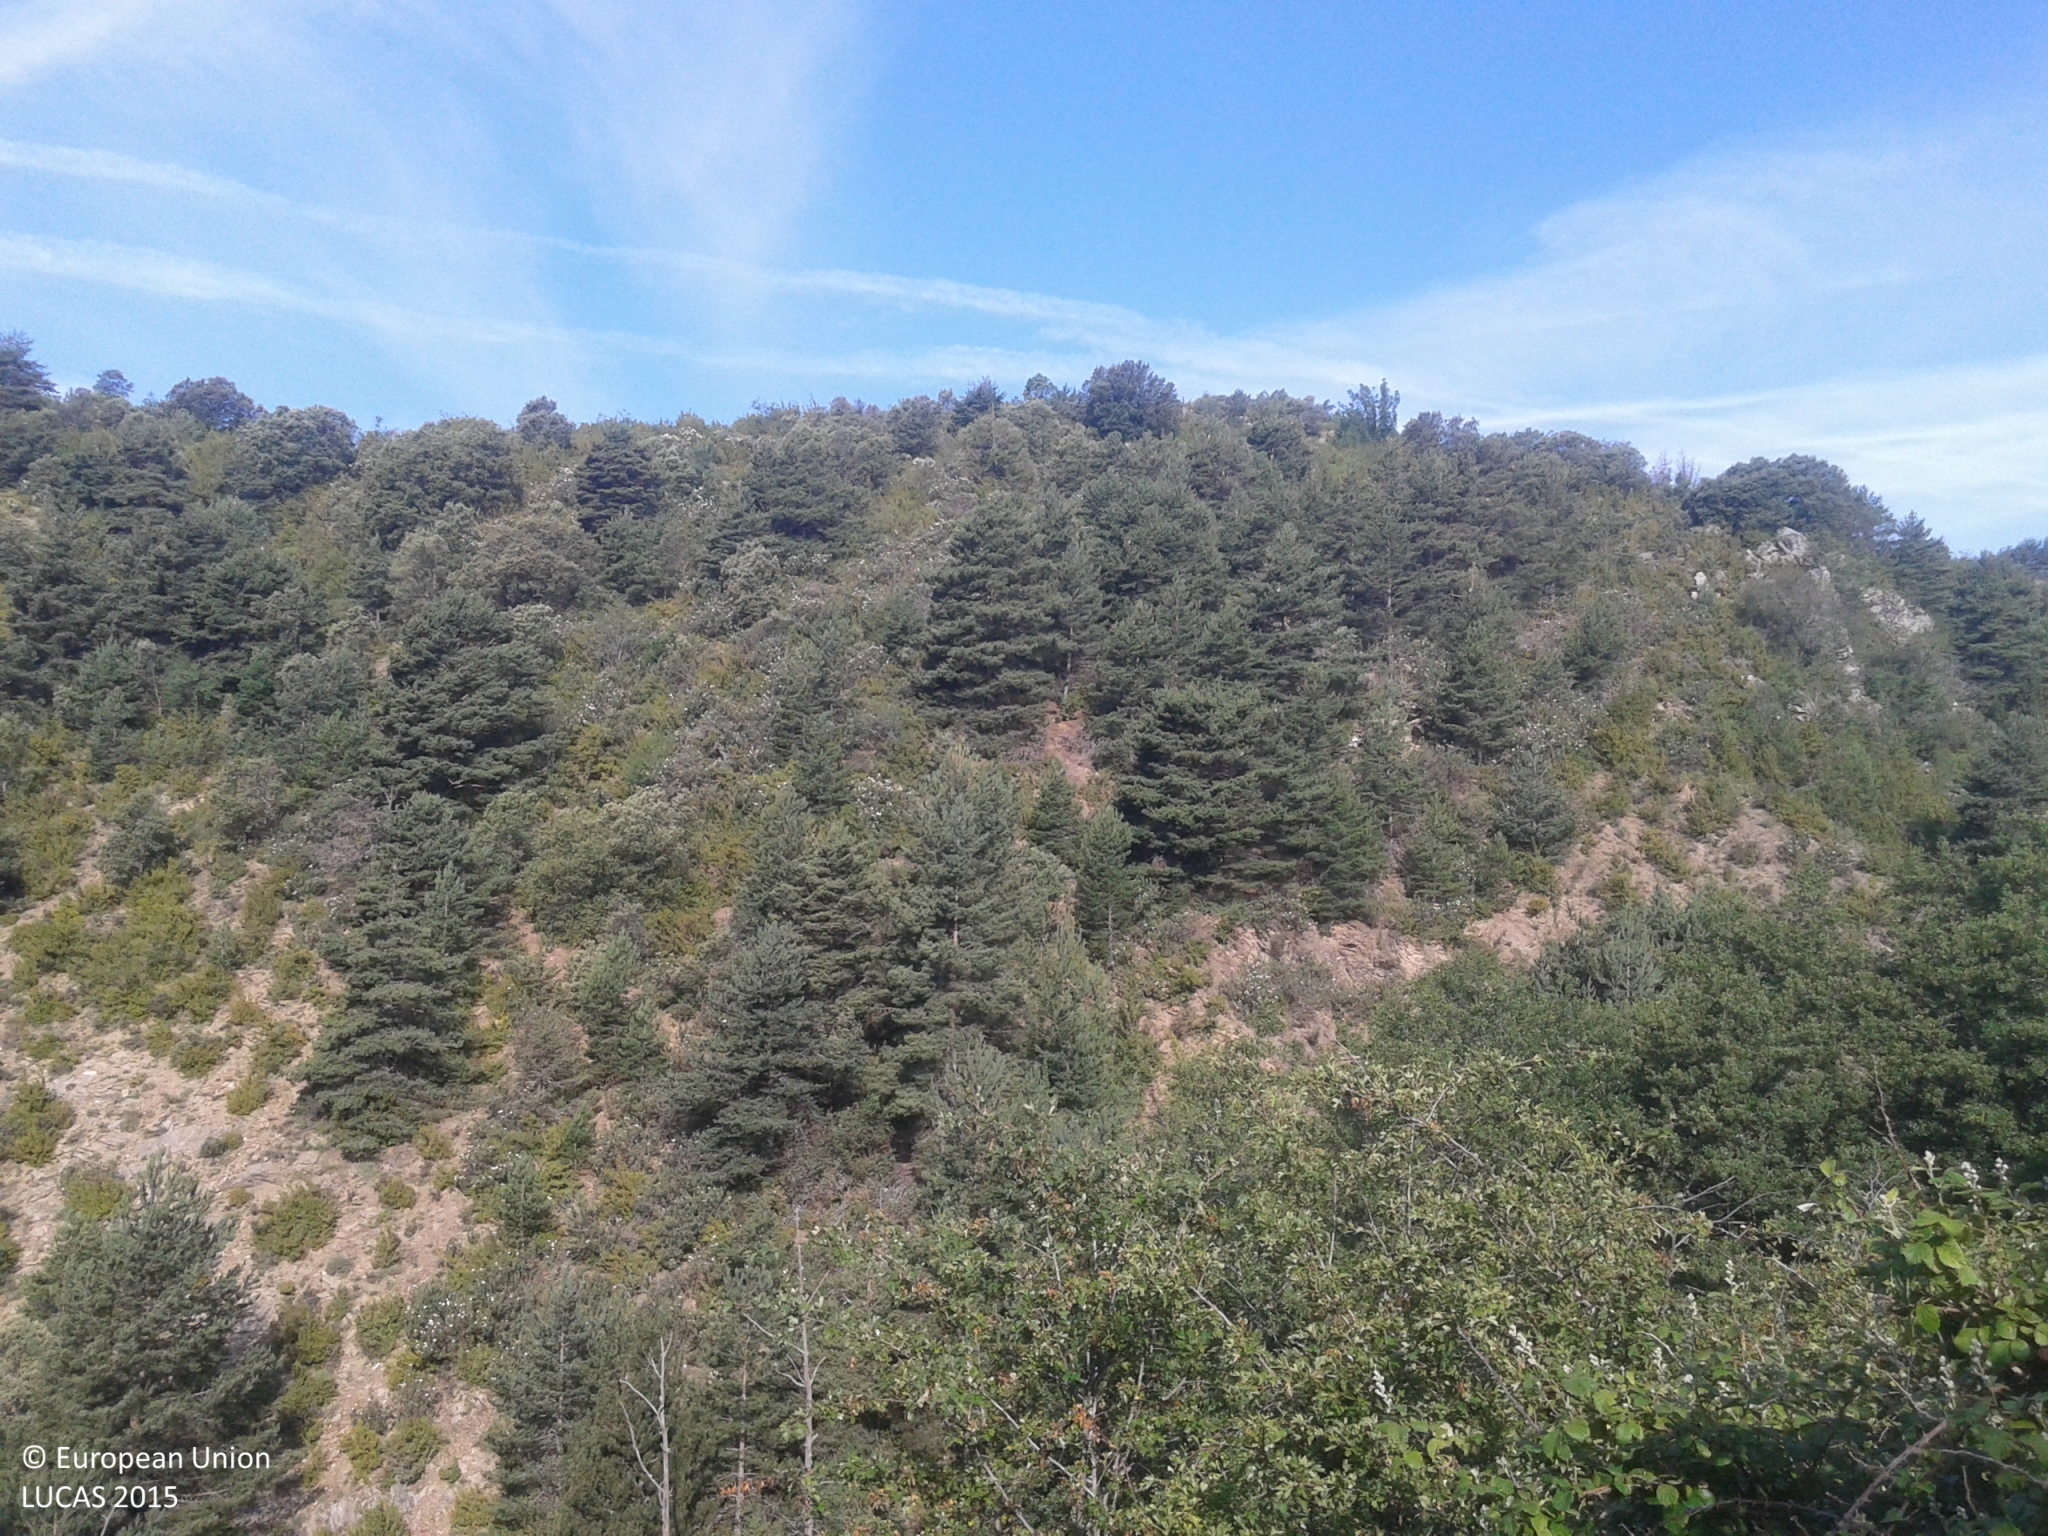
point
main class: Woodland
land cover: Pine dominated coniferous woodland
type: alpine coniferous forest
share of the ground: 25 - 50 %
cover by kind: shrubs 50 %, coniferous forest trees 30 %, unconsolidated bare surface 10 %, herbaceous plants 5 %, consolidated bare surface 5 %
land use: Semi-natural and natural areas not in use
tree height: > 5 m
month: June
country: ES
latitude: 42.3886
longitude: 1.5193
